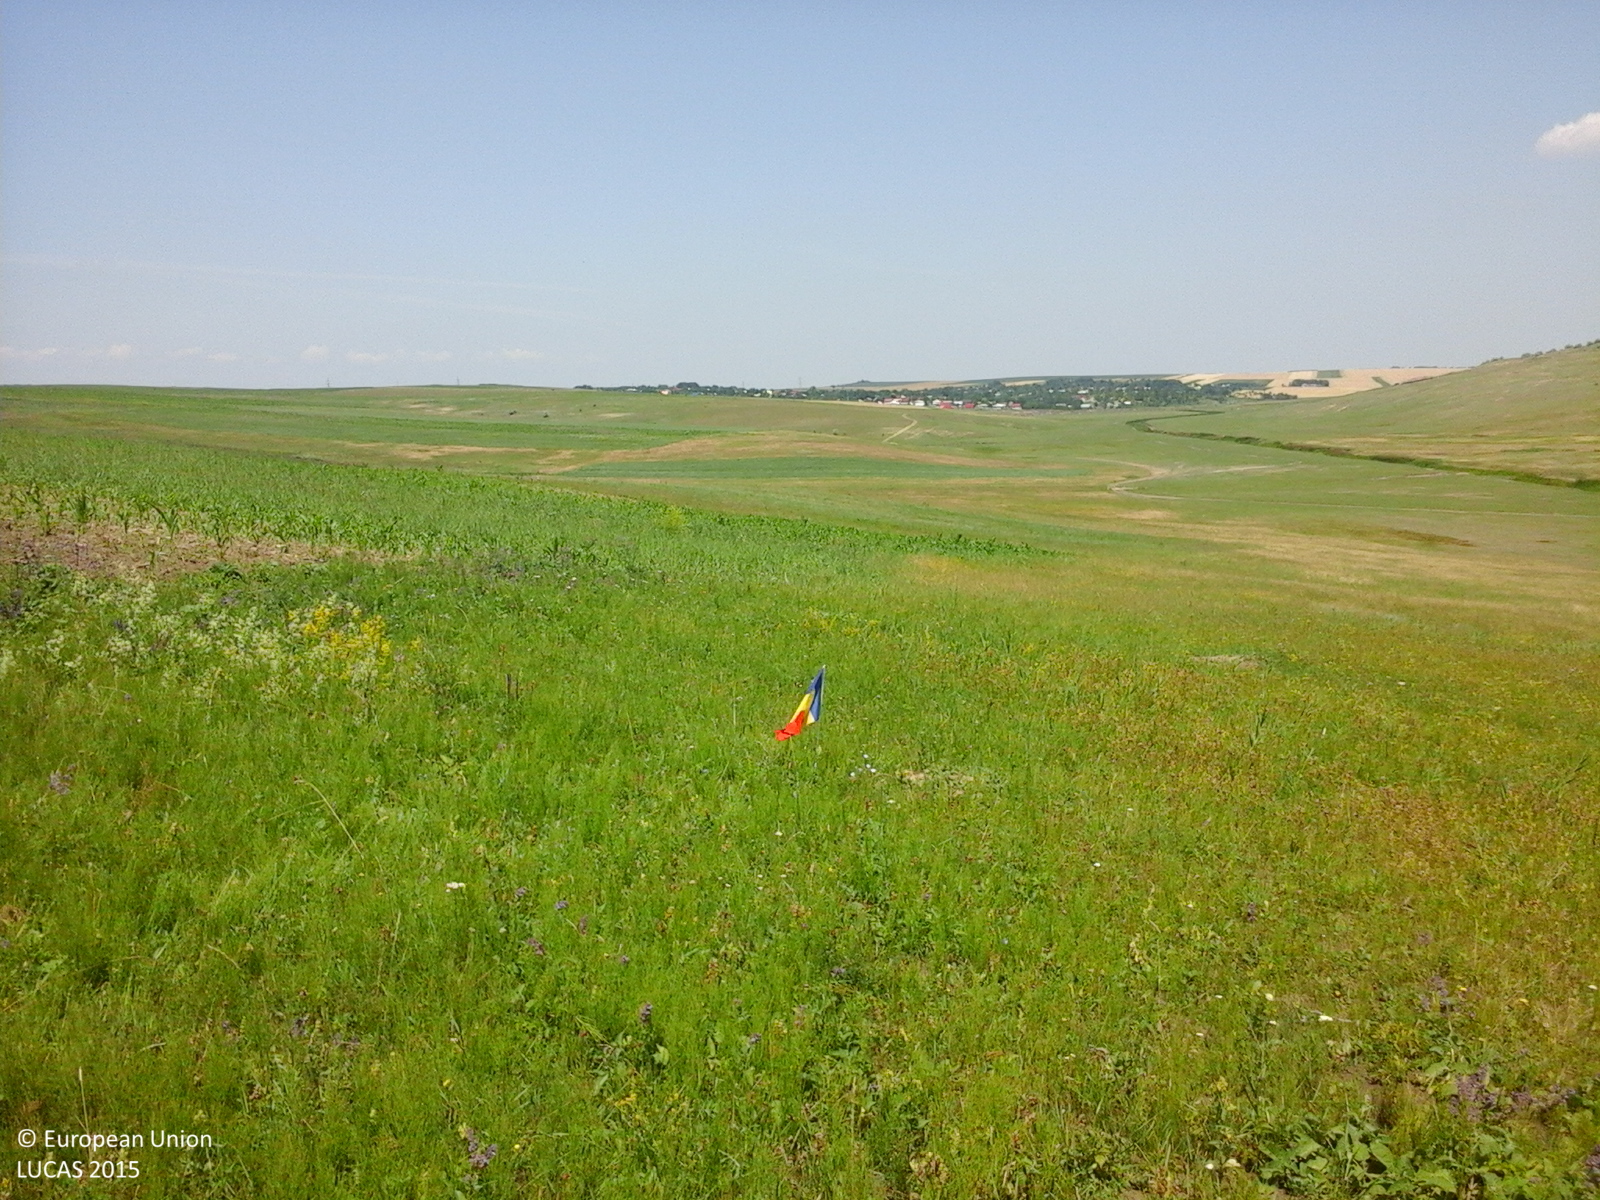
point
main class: Grassland
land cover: Grassland without tree/shrub cover
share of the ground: > 75 %
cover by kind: herbaceous plants 100 %
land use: Agriculture (excluding fallow land and kitchen gardens)
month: June
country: RO
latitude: 47.1720
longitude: 27.1920
